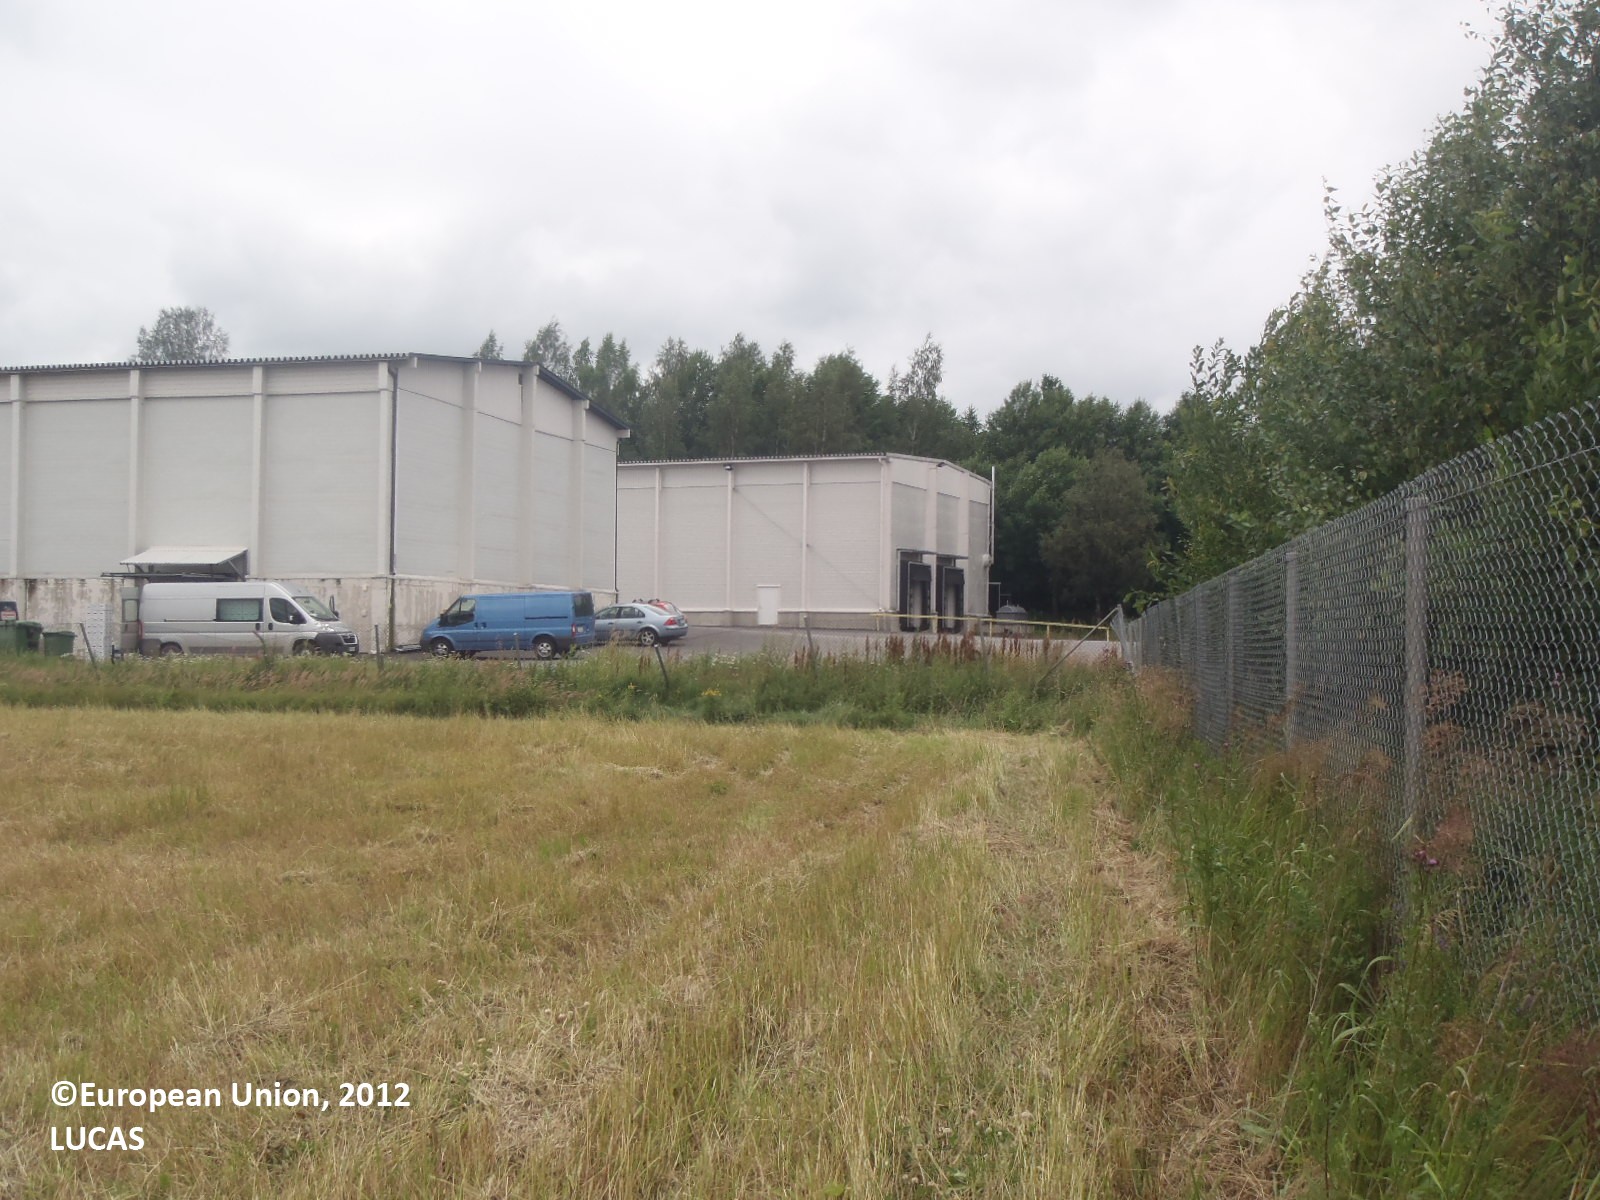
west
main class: Grassland
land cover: Grassland with sparse tree/shrub cover
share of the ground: > 75 %
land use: Abandoned areas
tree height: < 5 m
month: July
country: FI
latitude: 60.5024
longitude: 22.2469
